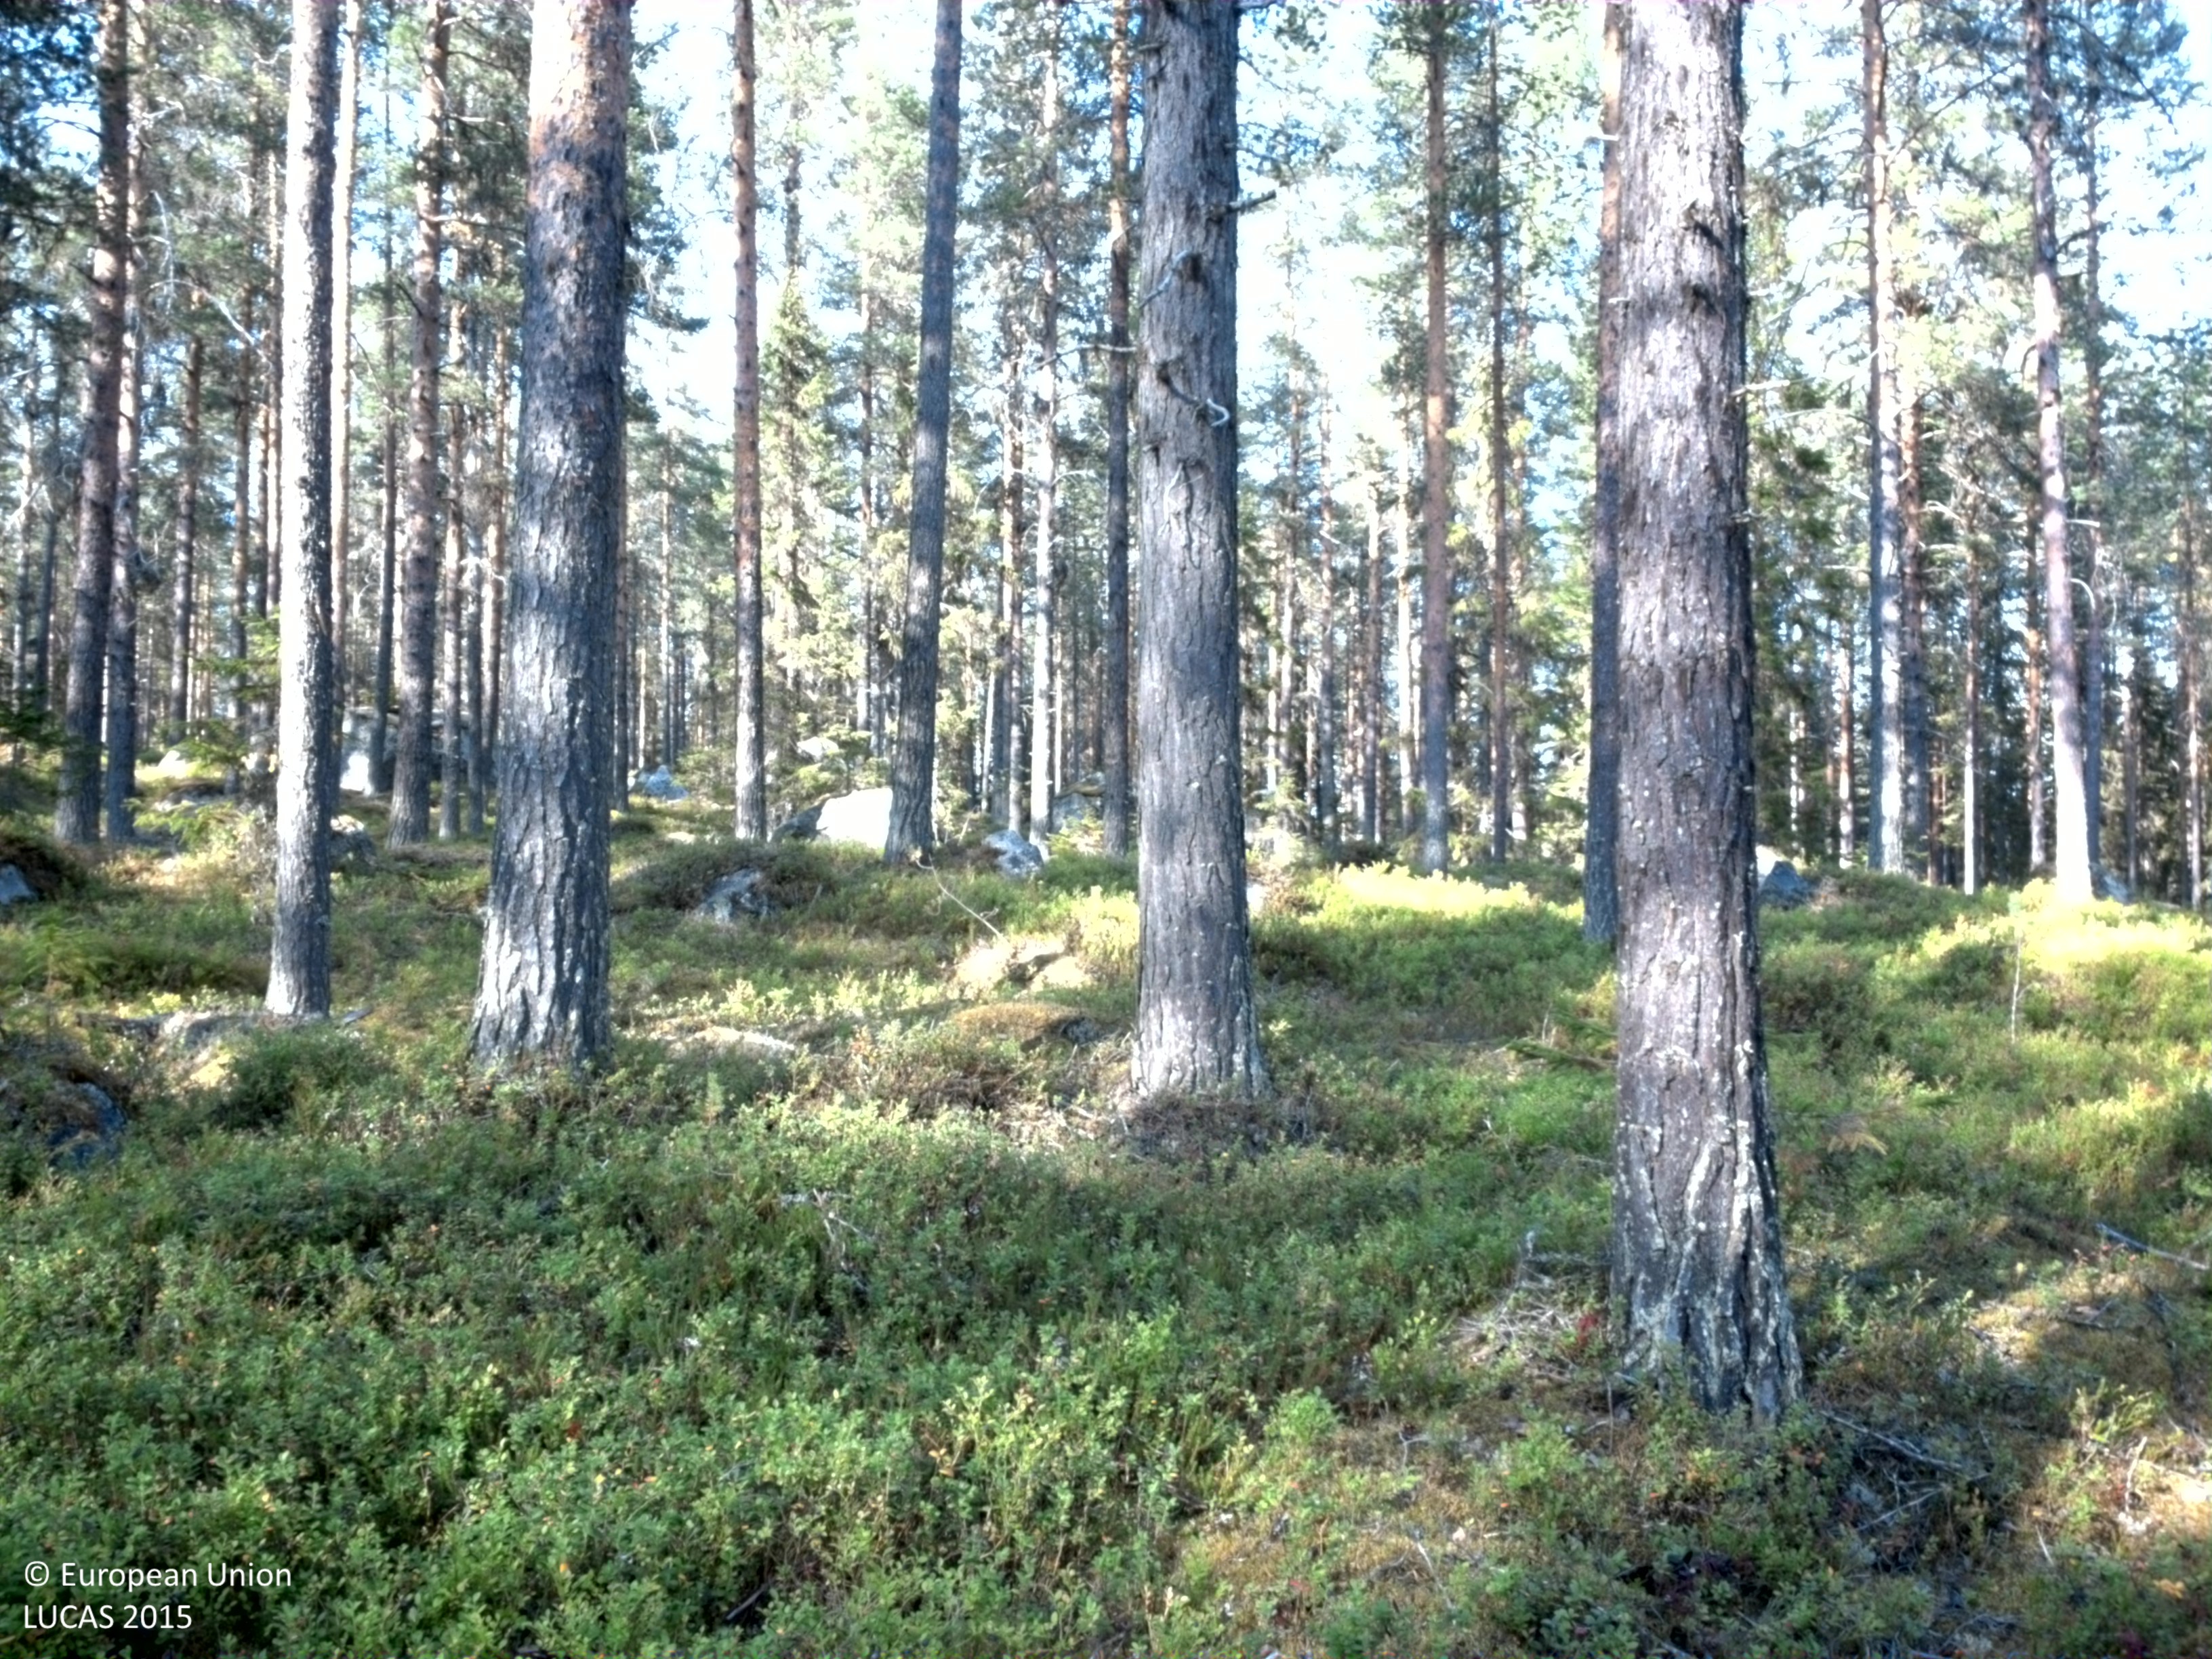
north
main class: Woodland
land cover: Pine dominated coniferous woodland
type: boreal forest
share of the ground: 50 - 75 %
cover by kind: coniferous forest trees 50 %, shrubs 45 %, lichens and mosses 5 %
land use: Forestry
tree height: > 5 m
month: August
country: SE
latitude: 64.4782
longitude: 18.8518
